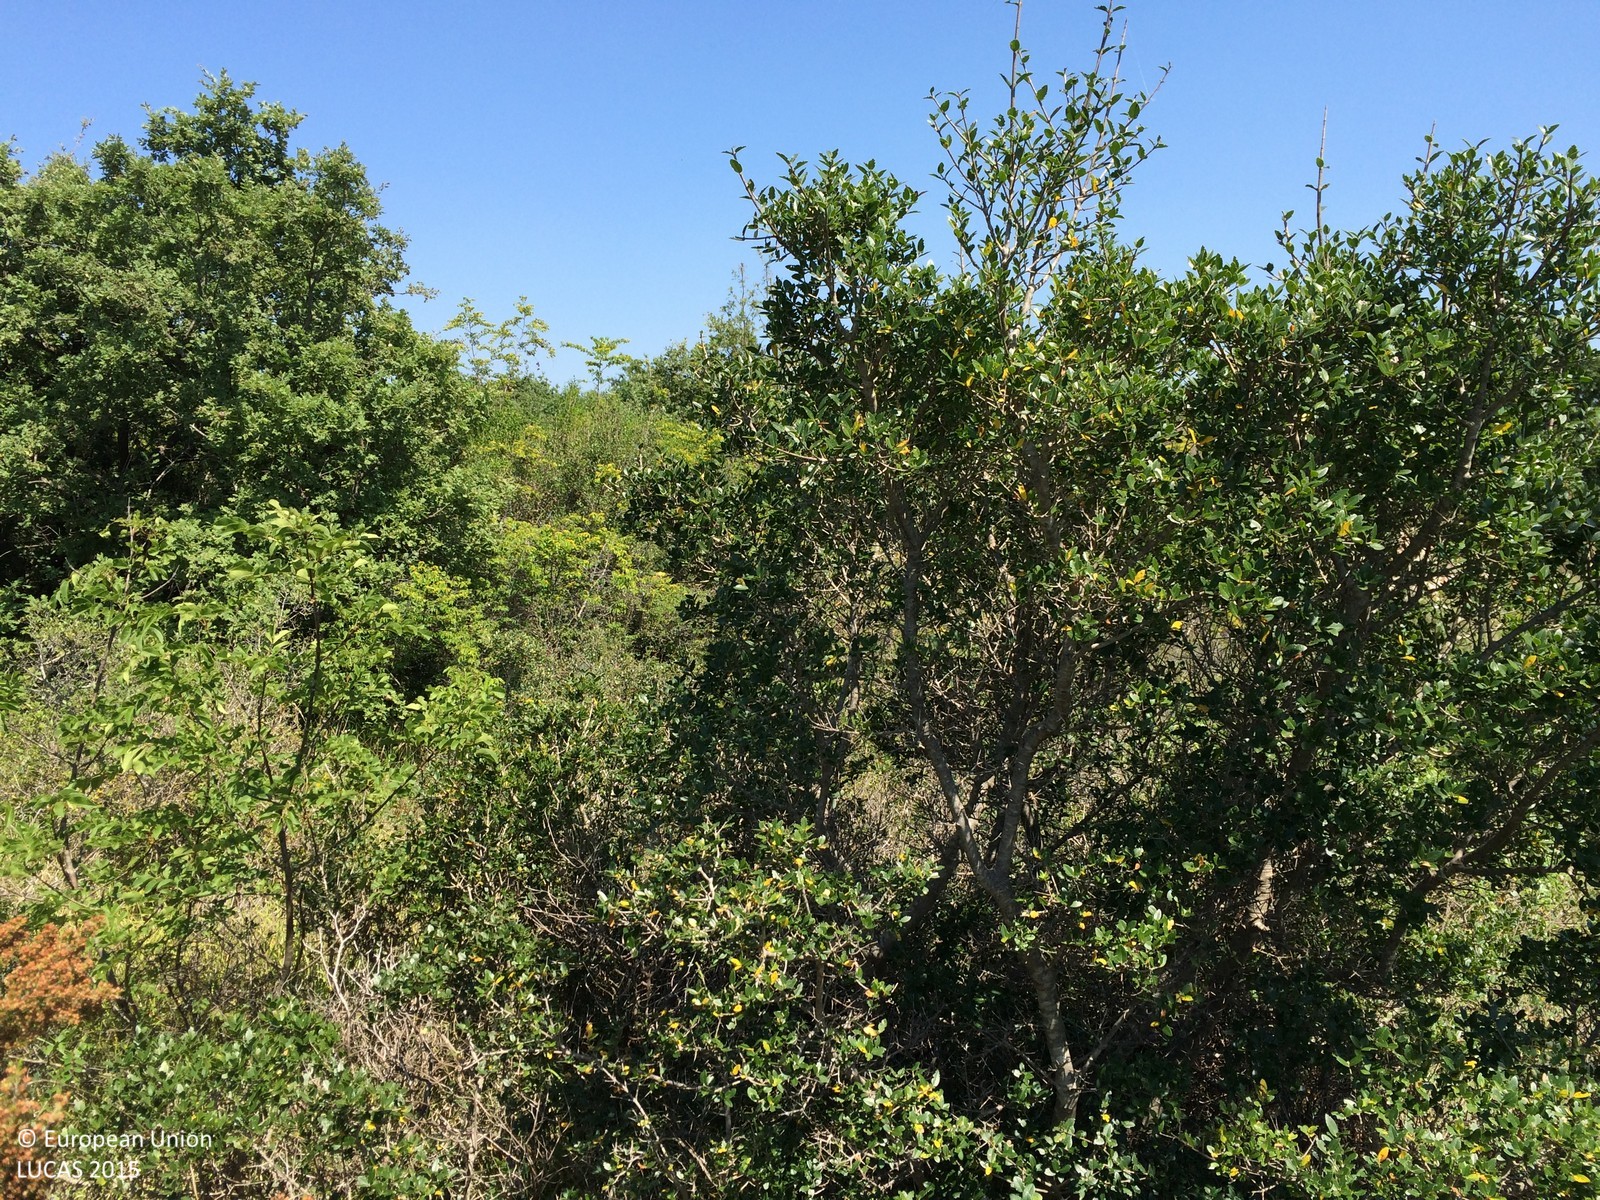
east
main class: Shrubland
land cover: Shrubland with sparse tree cover
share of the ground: > 75 %
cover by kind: shrubs 90 %, broadleaved forest trees 5 %, herbaceous plants 5 %
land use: Semi-natural and natural areas not in use
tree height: < 5 m
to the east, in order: Shrubland with sparse tree cover; Grassland with sparse tree/shrub cover; Rocks and stones; Broadleaved woodland; Shrubland with sparse tree cover; Grassland with sparse tree/shrub cover; Tracks; Grassland without tree/shrub cover; Tracks; Shrubland with sparse tree cover; Grass margins; Paved roads, cycling and walking lanes; Grass margins; Broadleaved woodland; Shrubland with sparse tree cover
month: June
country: HR
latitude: 45.0025
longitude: 13.8130
